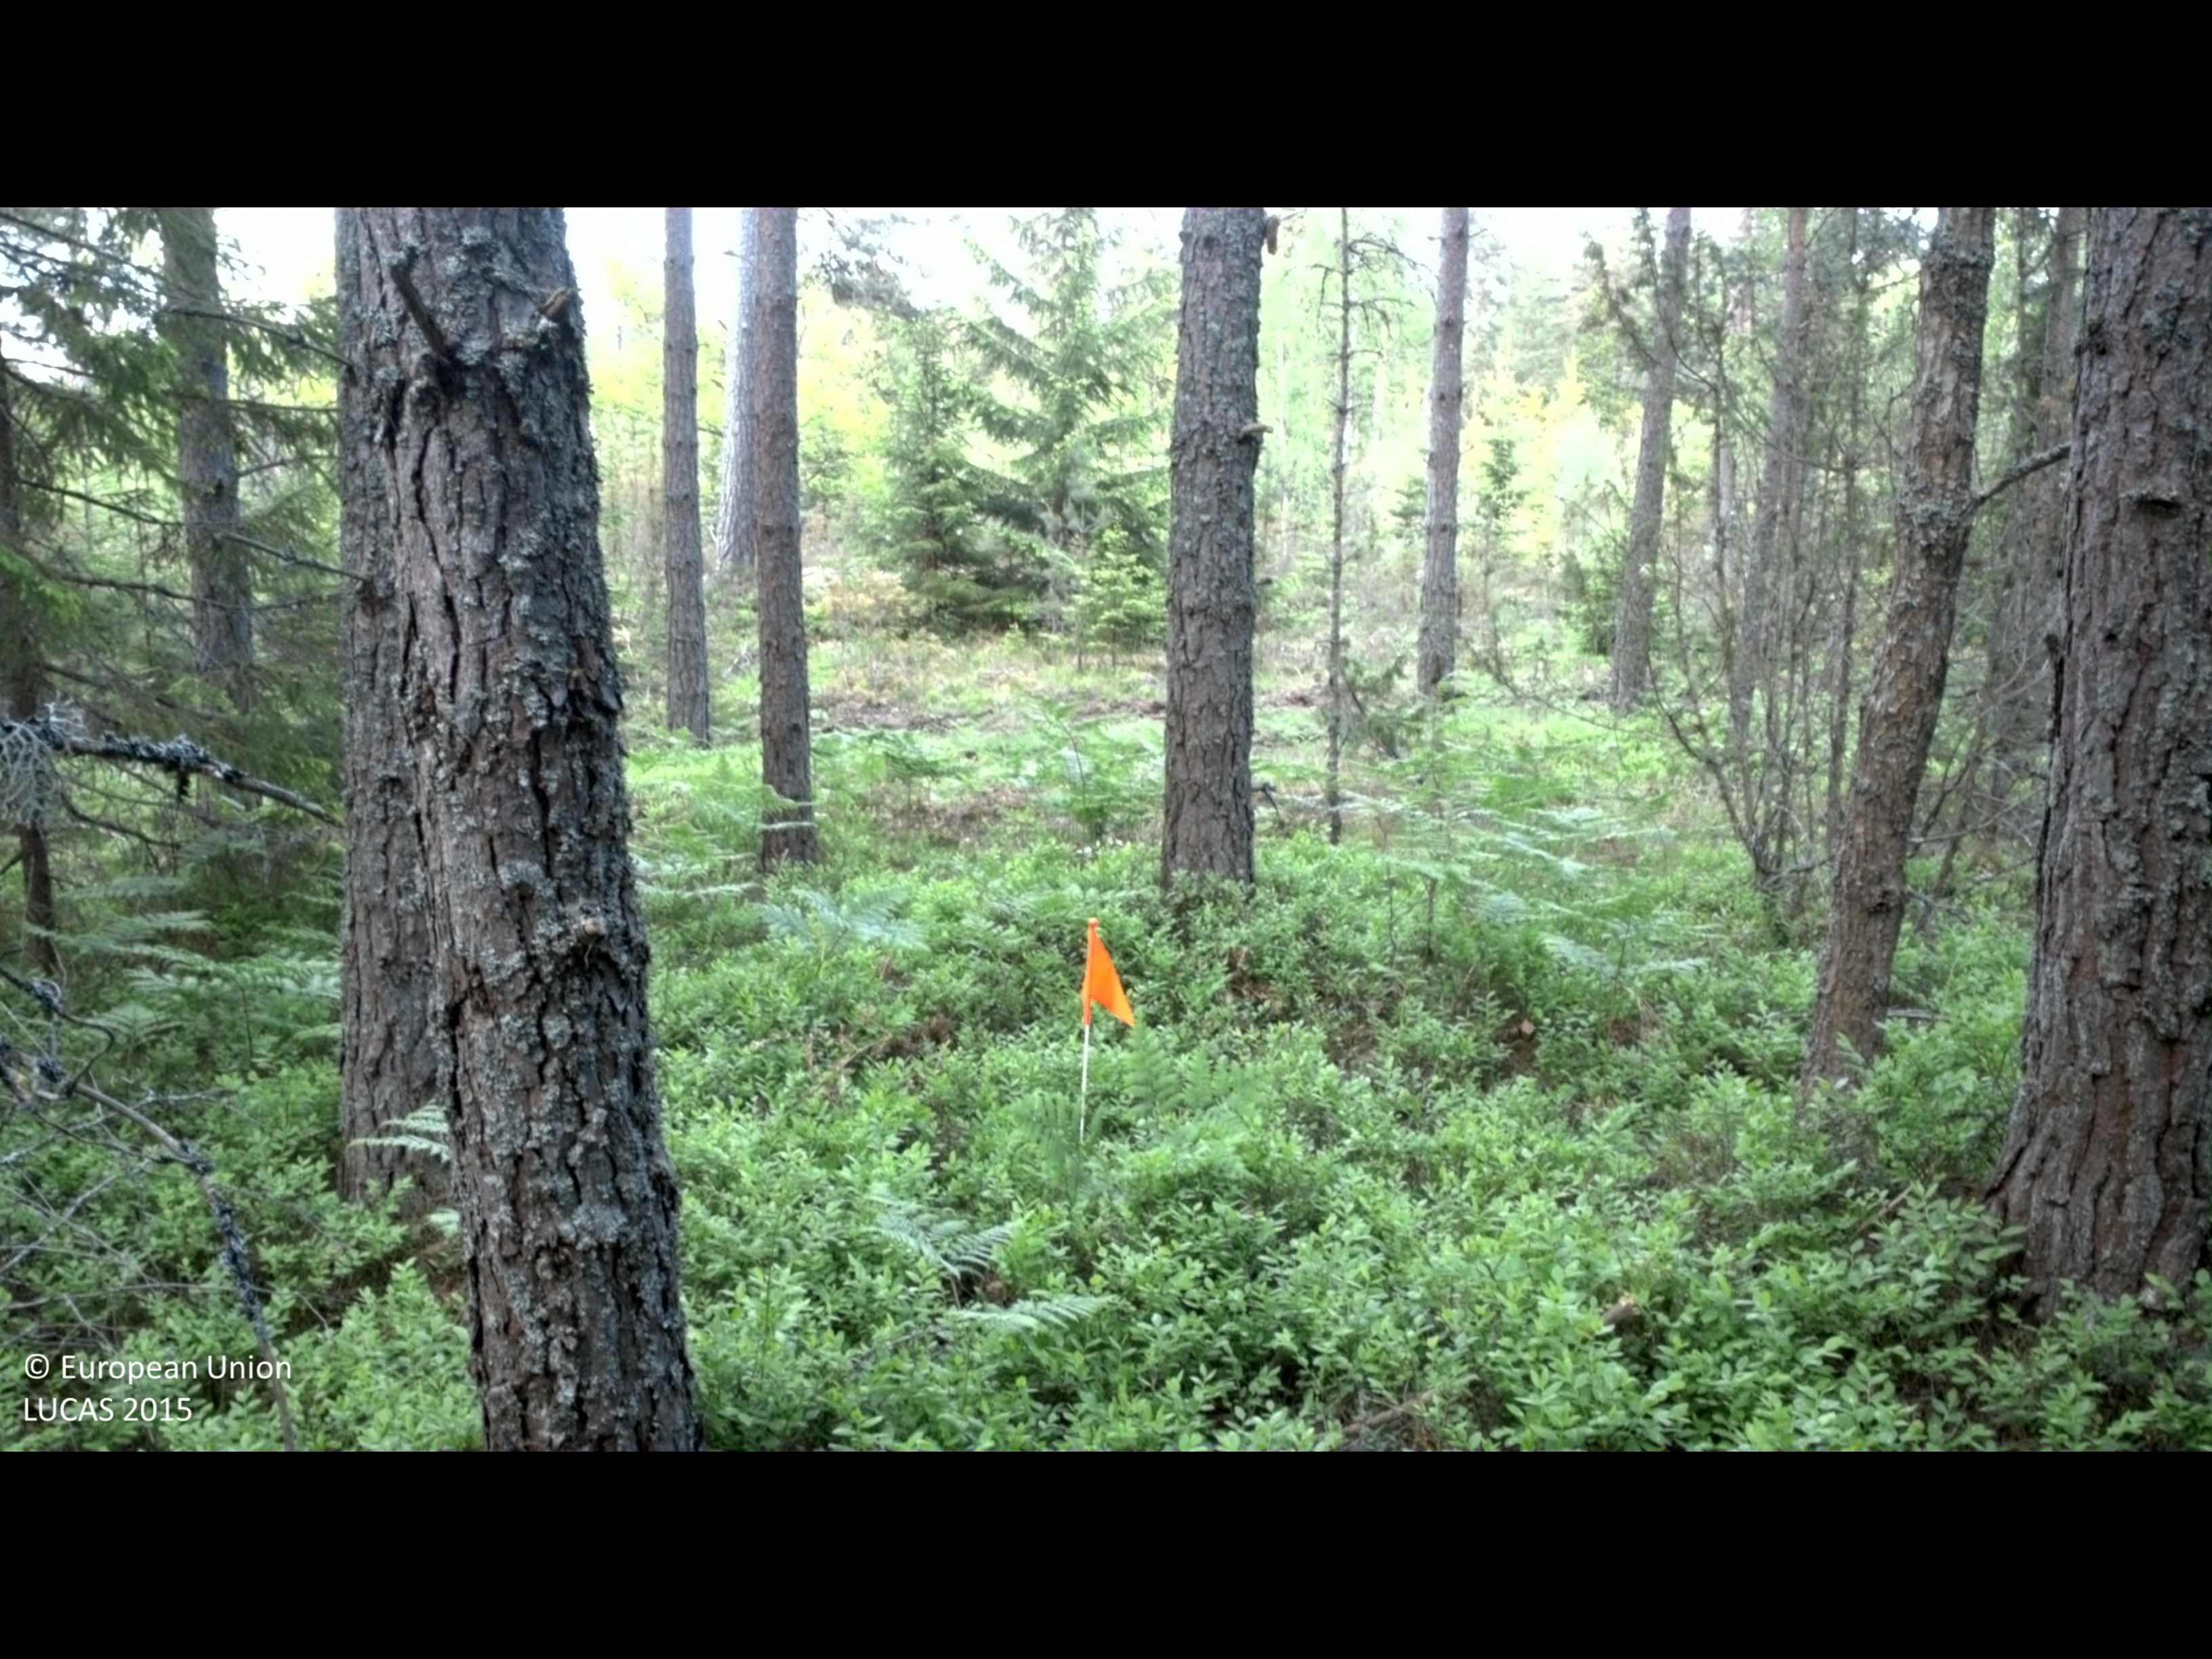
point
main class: Woodland
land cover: Pine dominated coniferous woodland
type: boreal forest
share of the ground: 50 - 75 %
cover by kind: coniferous forest trees 65 %, shrubs 15 %, lichens and mosses 10 %, broadleaved forest trees 5 %, herbaceous plants 5 %
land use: Forestry
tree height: > 5 m
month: May
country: SE
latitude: 57.4494
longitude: 16.4816
